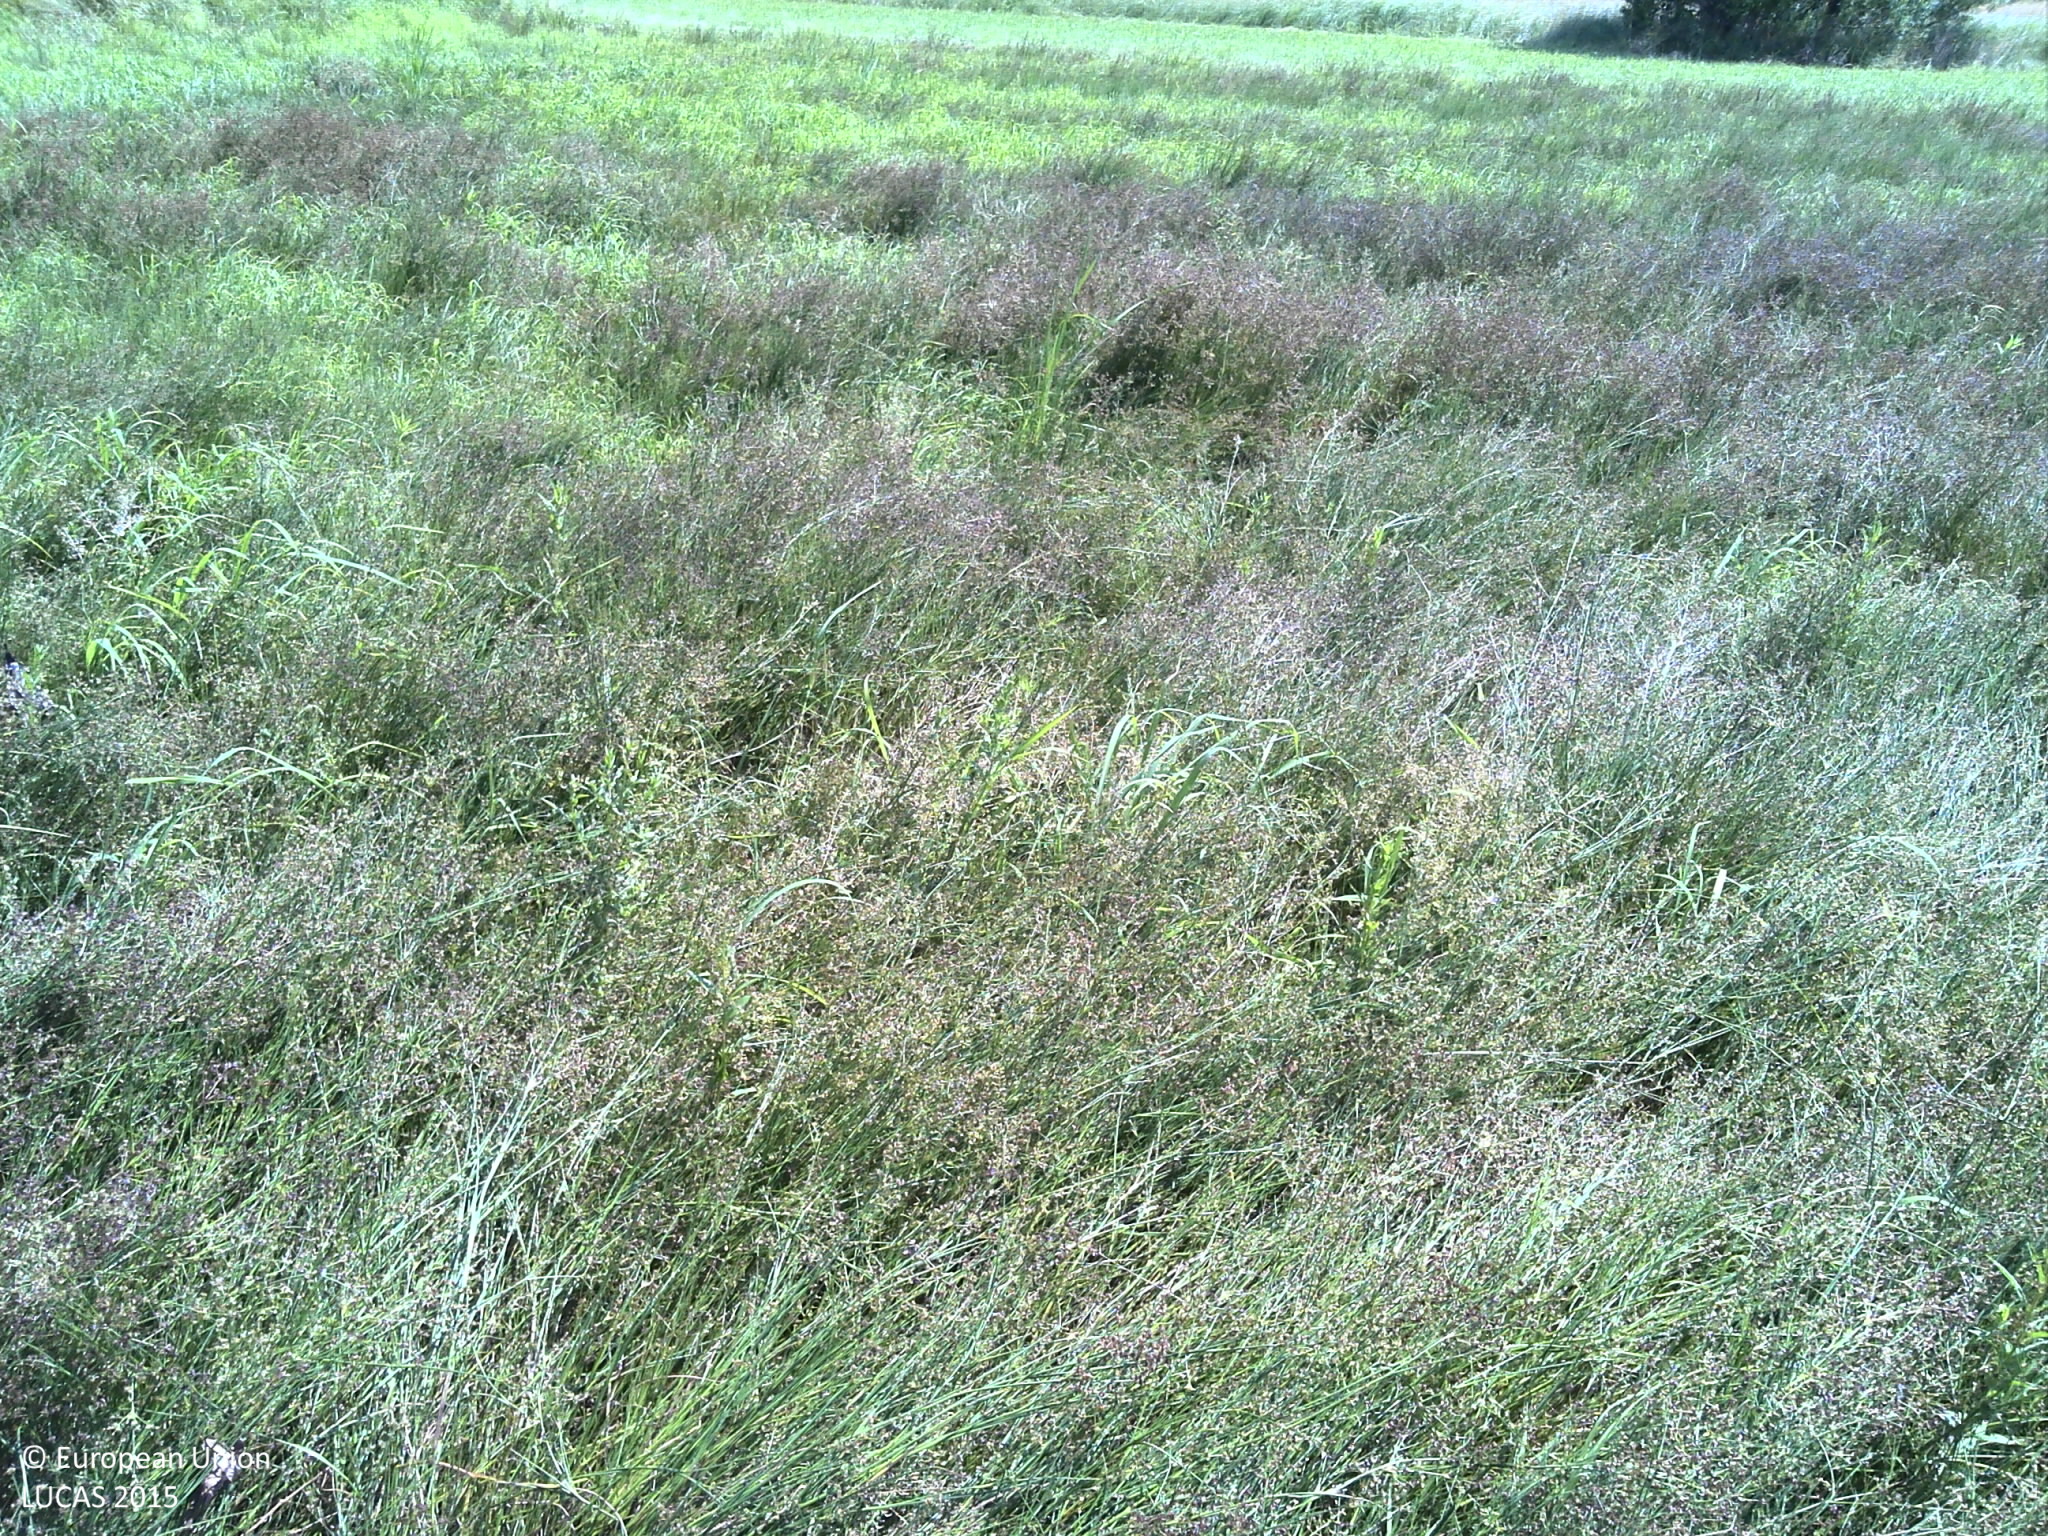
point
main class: Grassland
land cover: Spontaneously vegetated surfaces
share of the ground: > 75 %
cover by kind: herbaceous plants 100 %
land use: Fallow land
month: June
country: HR
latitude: 45.9610
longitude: 17.2409
